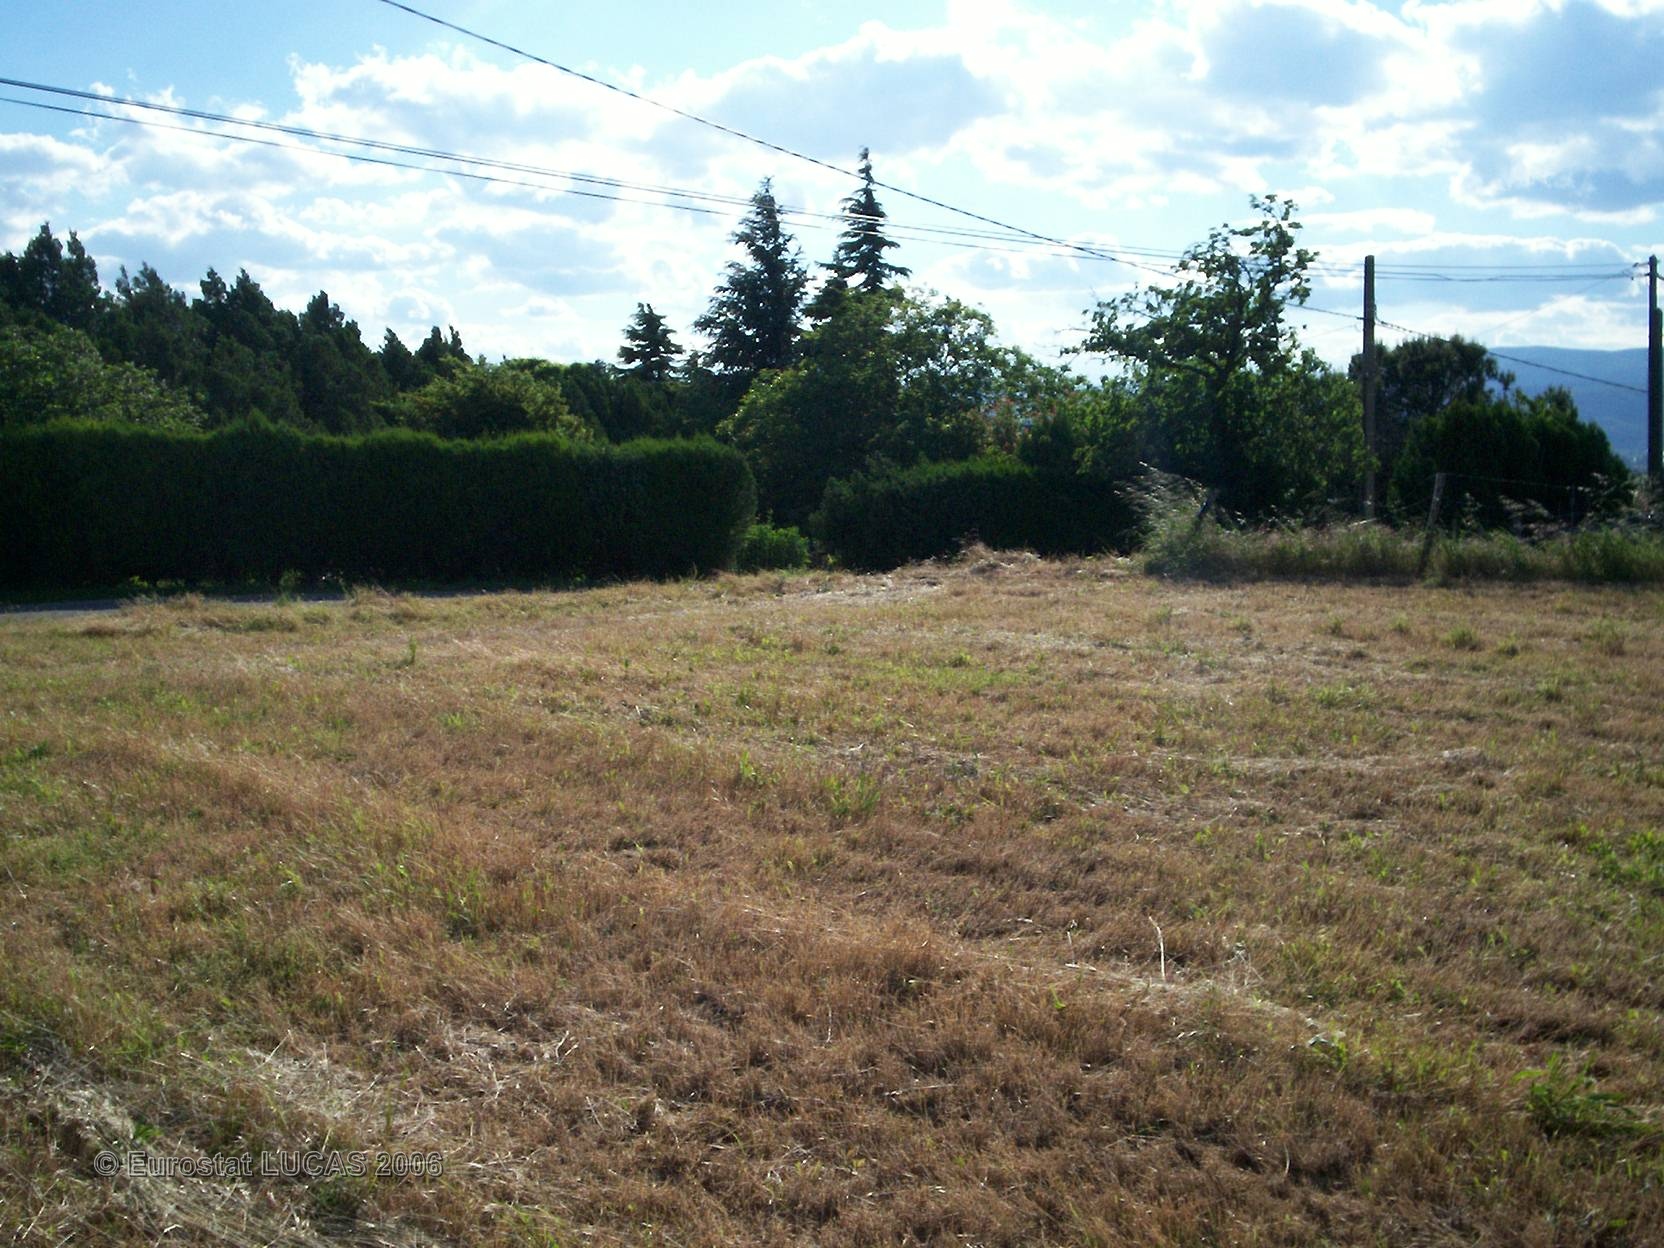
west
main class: Grassland
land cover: Grassland without tree/shrub cover
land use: Agriculture (excluding fallow land and kitchen gardens)
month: May
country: FR
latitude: 44.7269
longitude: 4.8169
